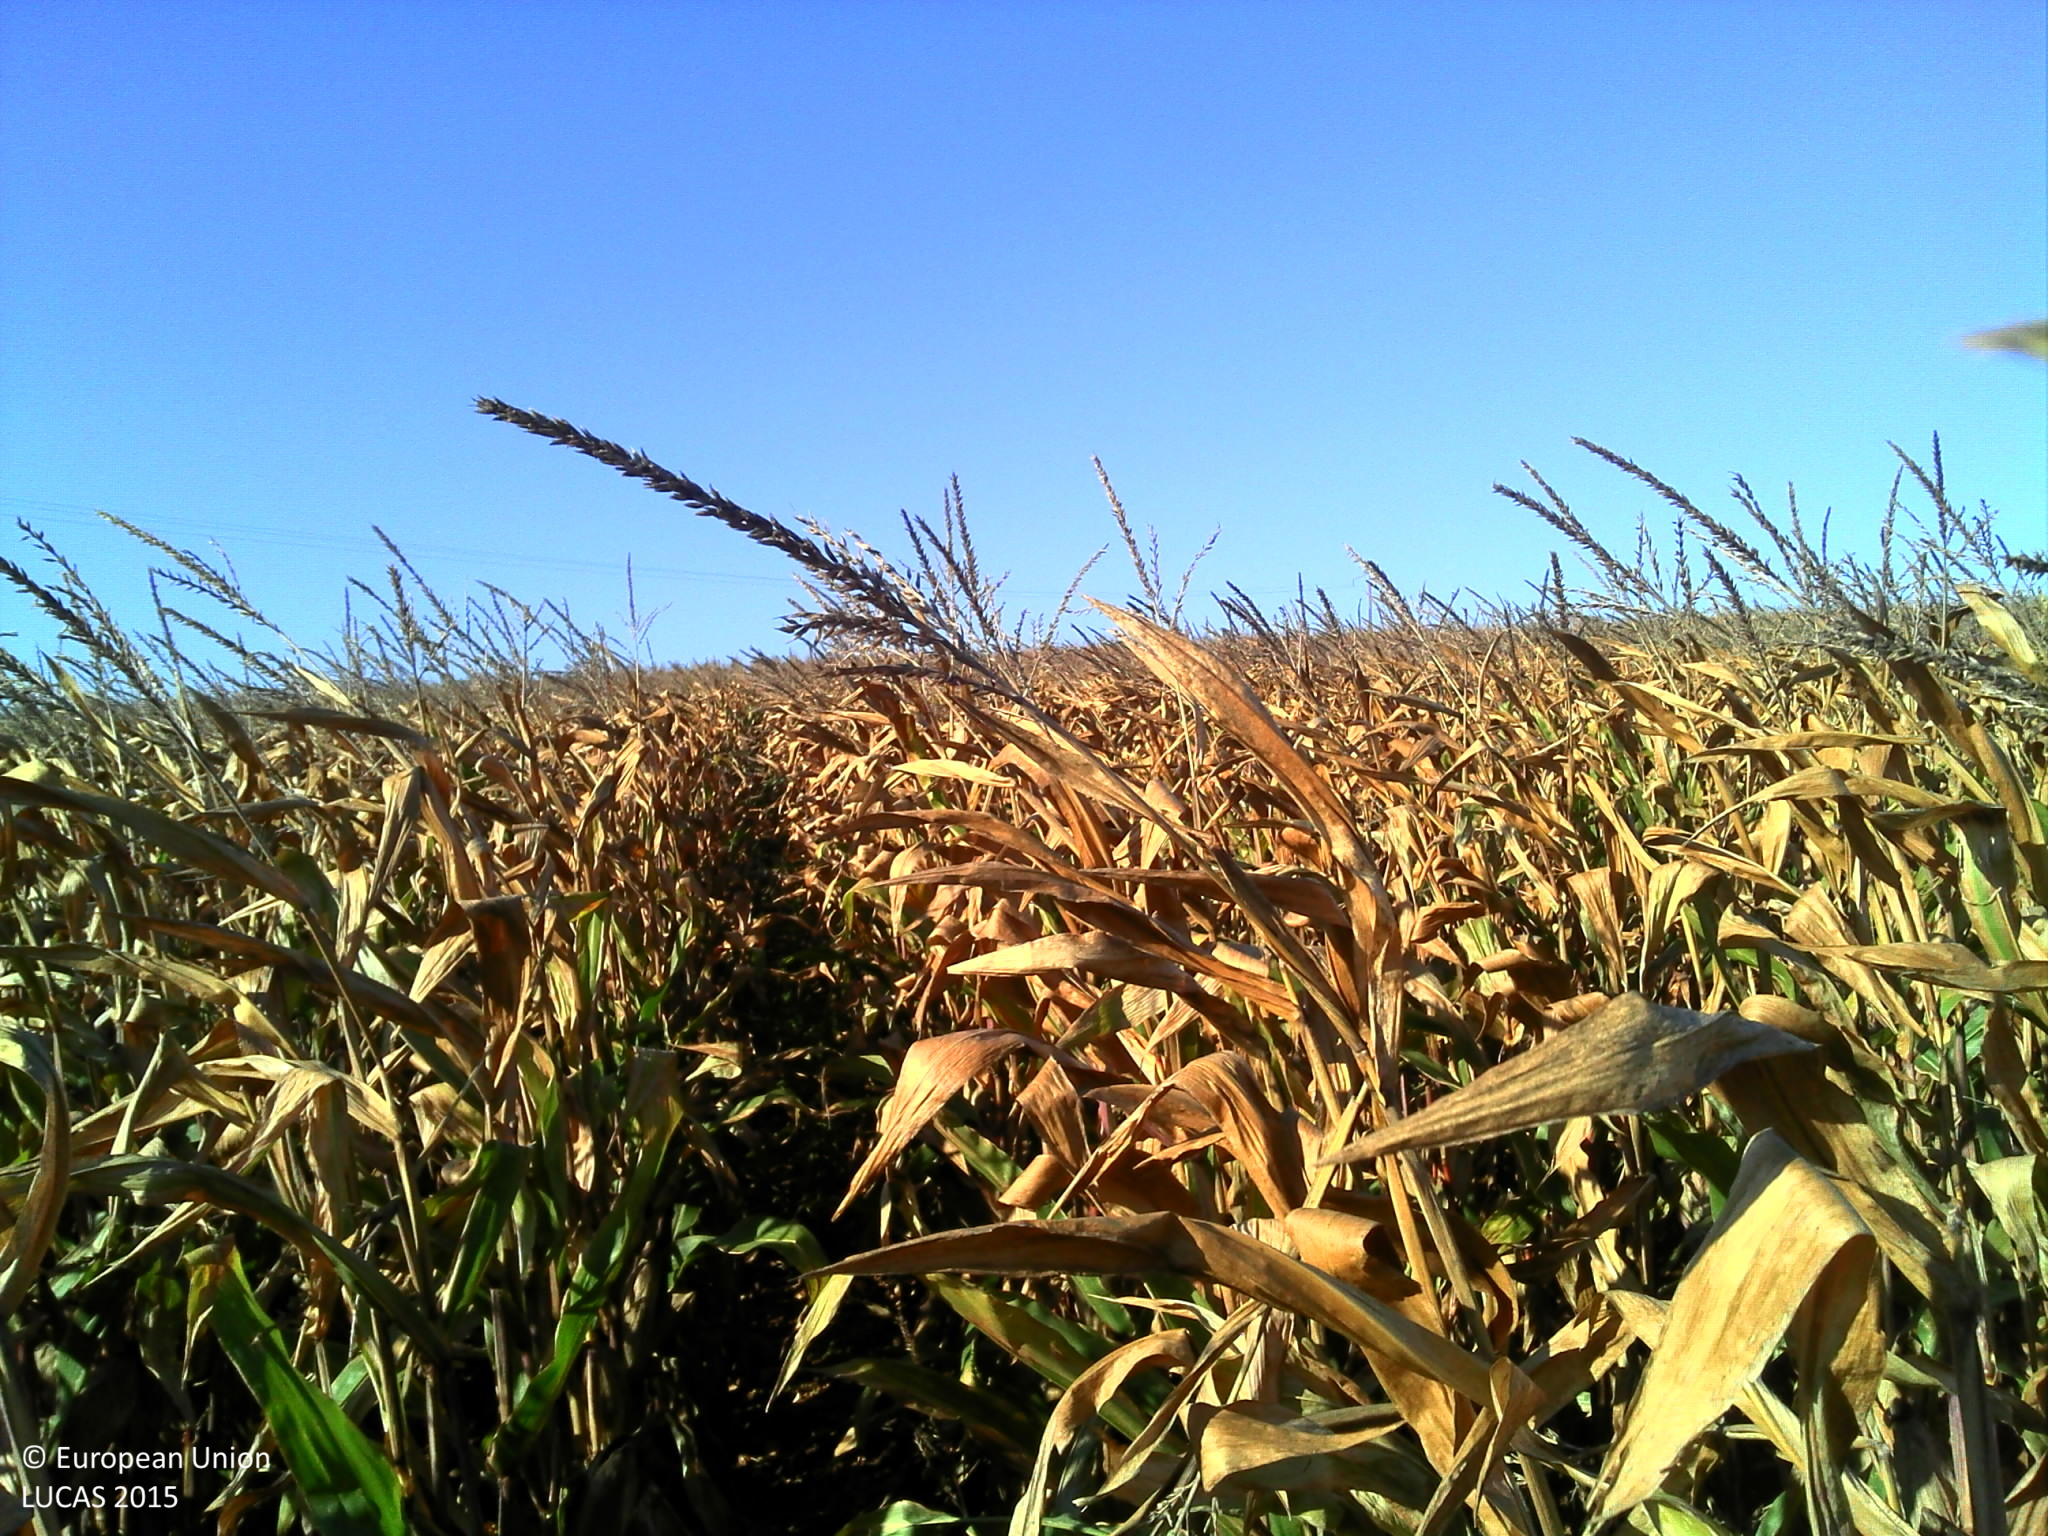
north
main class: Cropland
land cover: Maize
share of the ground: 50 - 75 %
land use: Agriculture (excluding fallow land and kitchen gardens)
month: September
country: FR
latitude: 46.5674
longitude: -1.1362
